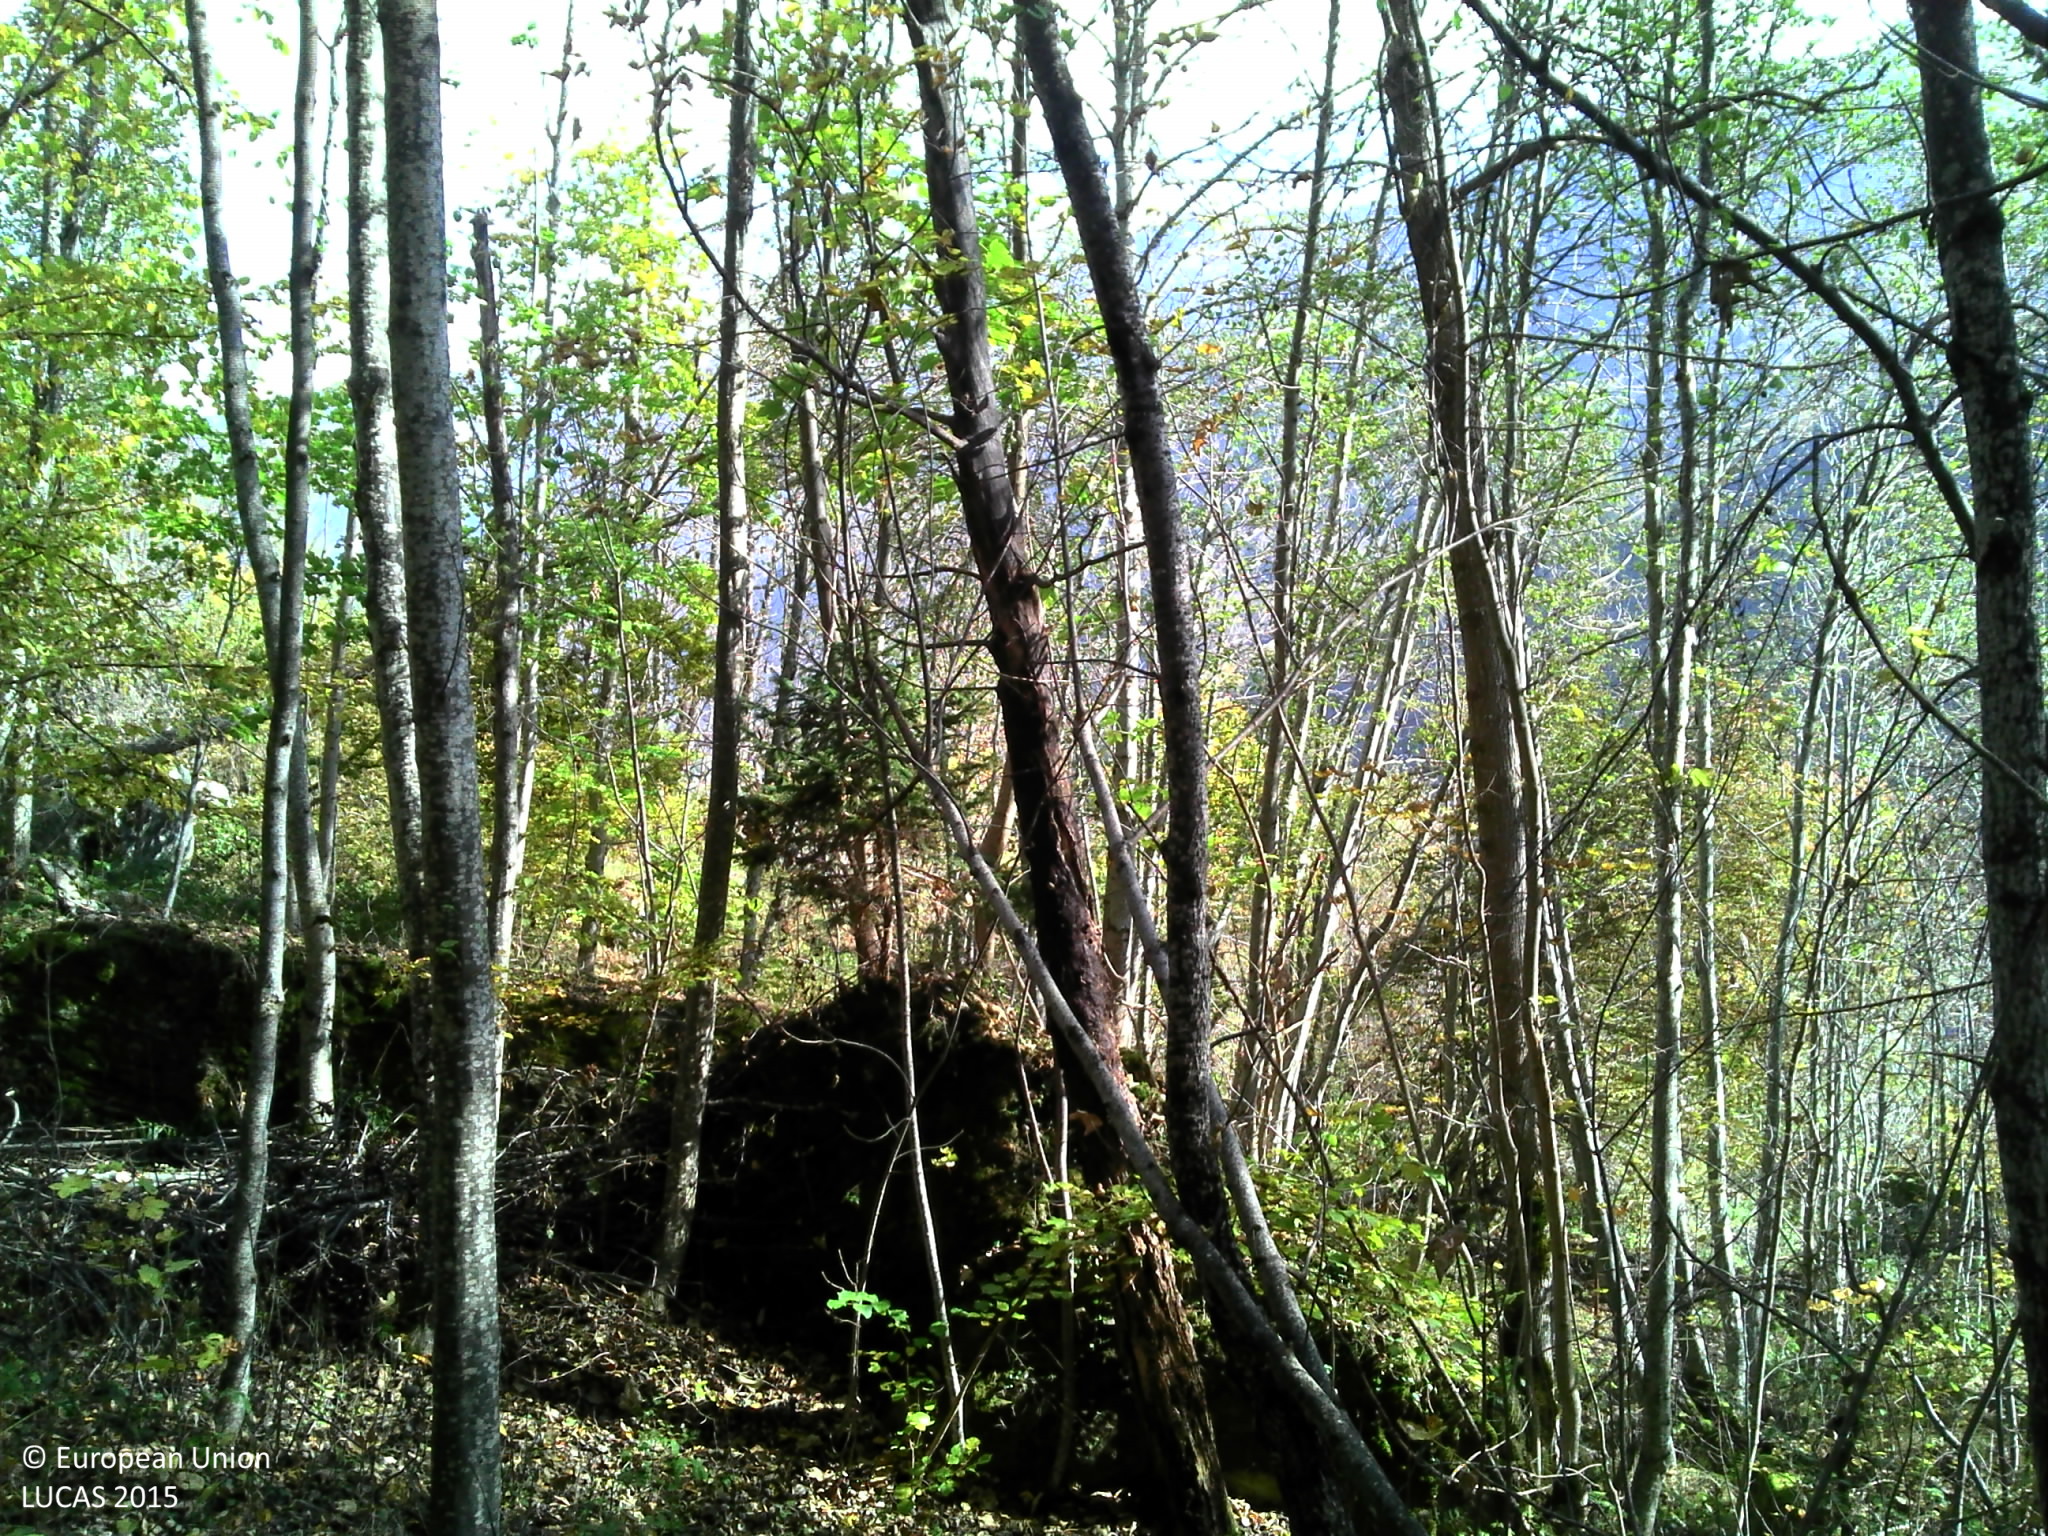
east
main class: Woodland
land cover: Broadleaved woodland
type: mesophytic deciduous forest
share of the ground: > 75 %
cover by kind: broadleaved forest trees 80 %, unconsolidated bare surface 10 %, shrubs 5 %, lichens and mosses 5 %
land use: Forestry
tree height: > 5 m
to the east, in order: Broadleaved woodland; Rivers and streams; Tracks; Broadleaved woodland; Spontaneously vegetated surfaces; Tracks; Broadleaved woodland; Grassland with sparse tree/shrub cover; Dry stone walls; Tracks; Grassland with sparse tree/shrub cover; Broadleaved woodland; Tracks; Broadleaved woodland; Grassland without tree/shrub cover
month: October
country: FR
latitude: 45.2924
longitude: 6.2181
